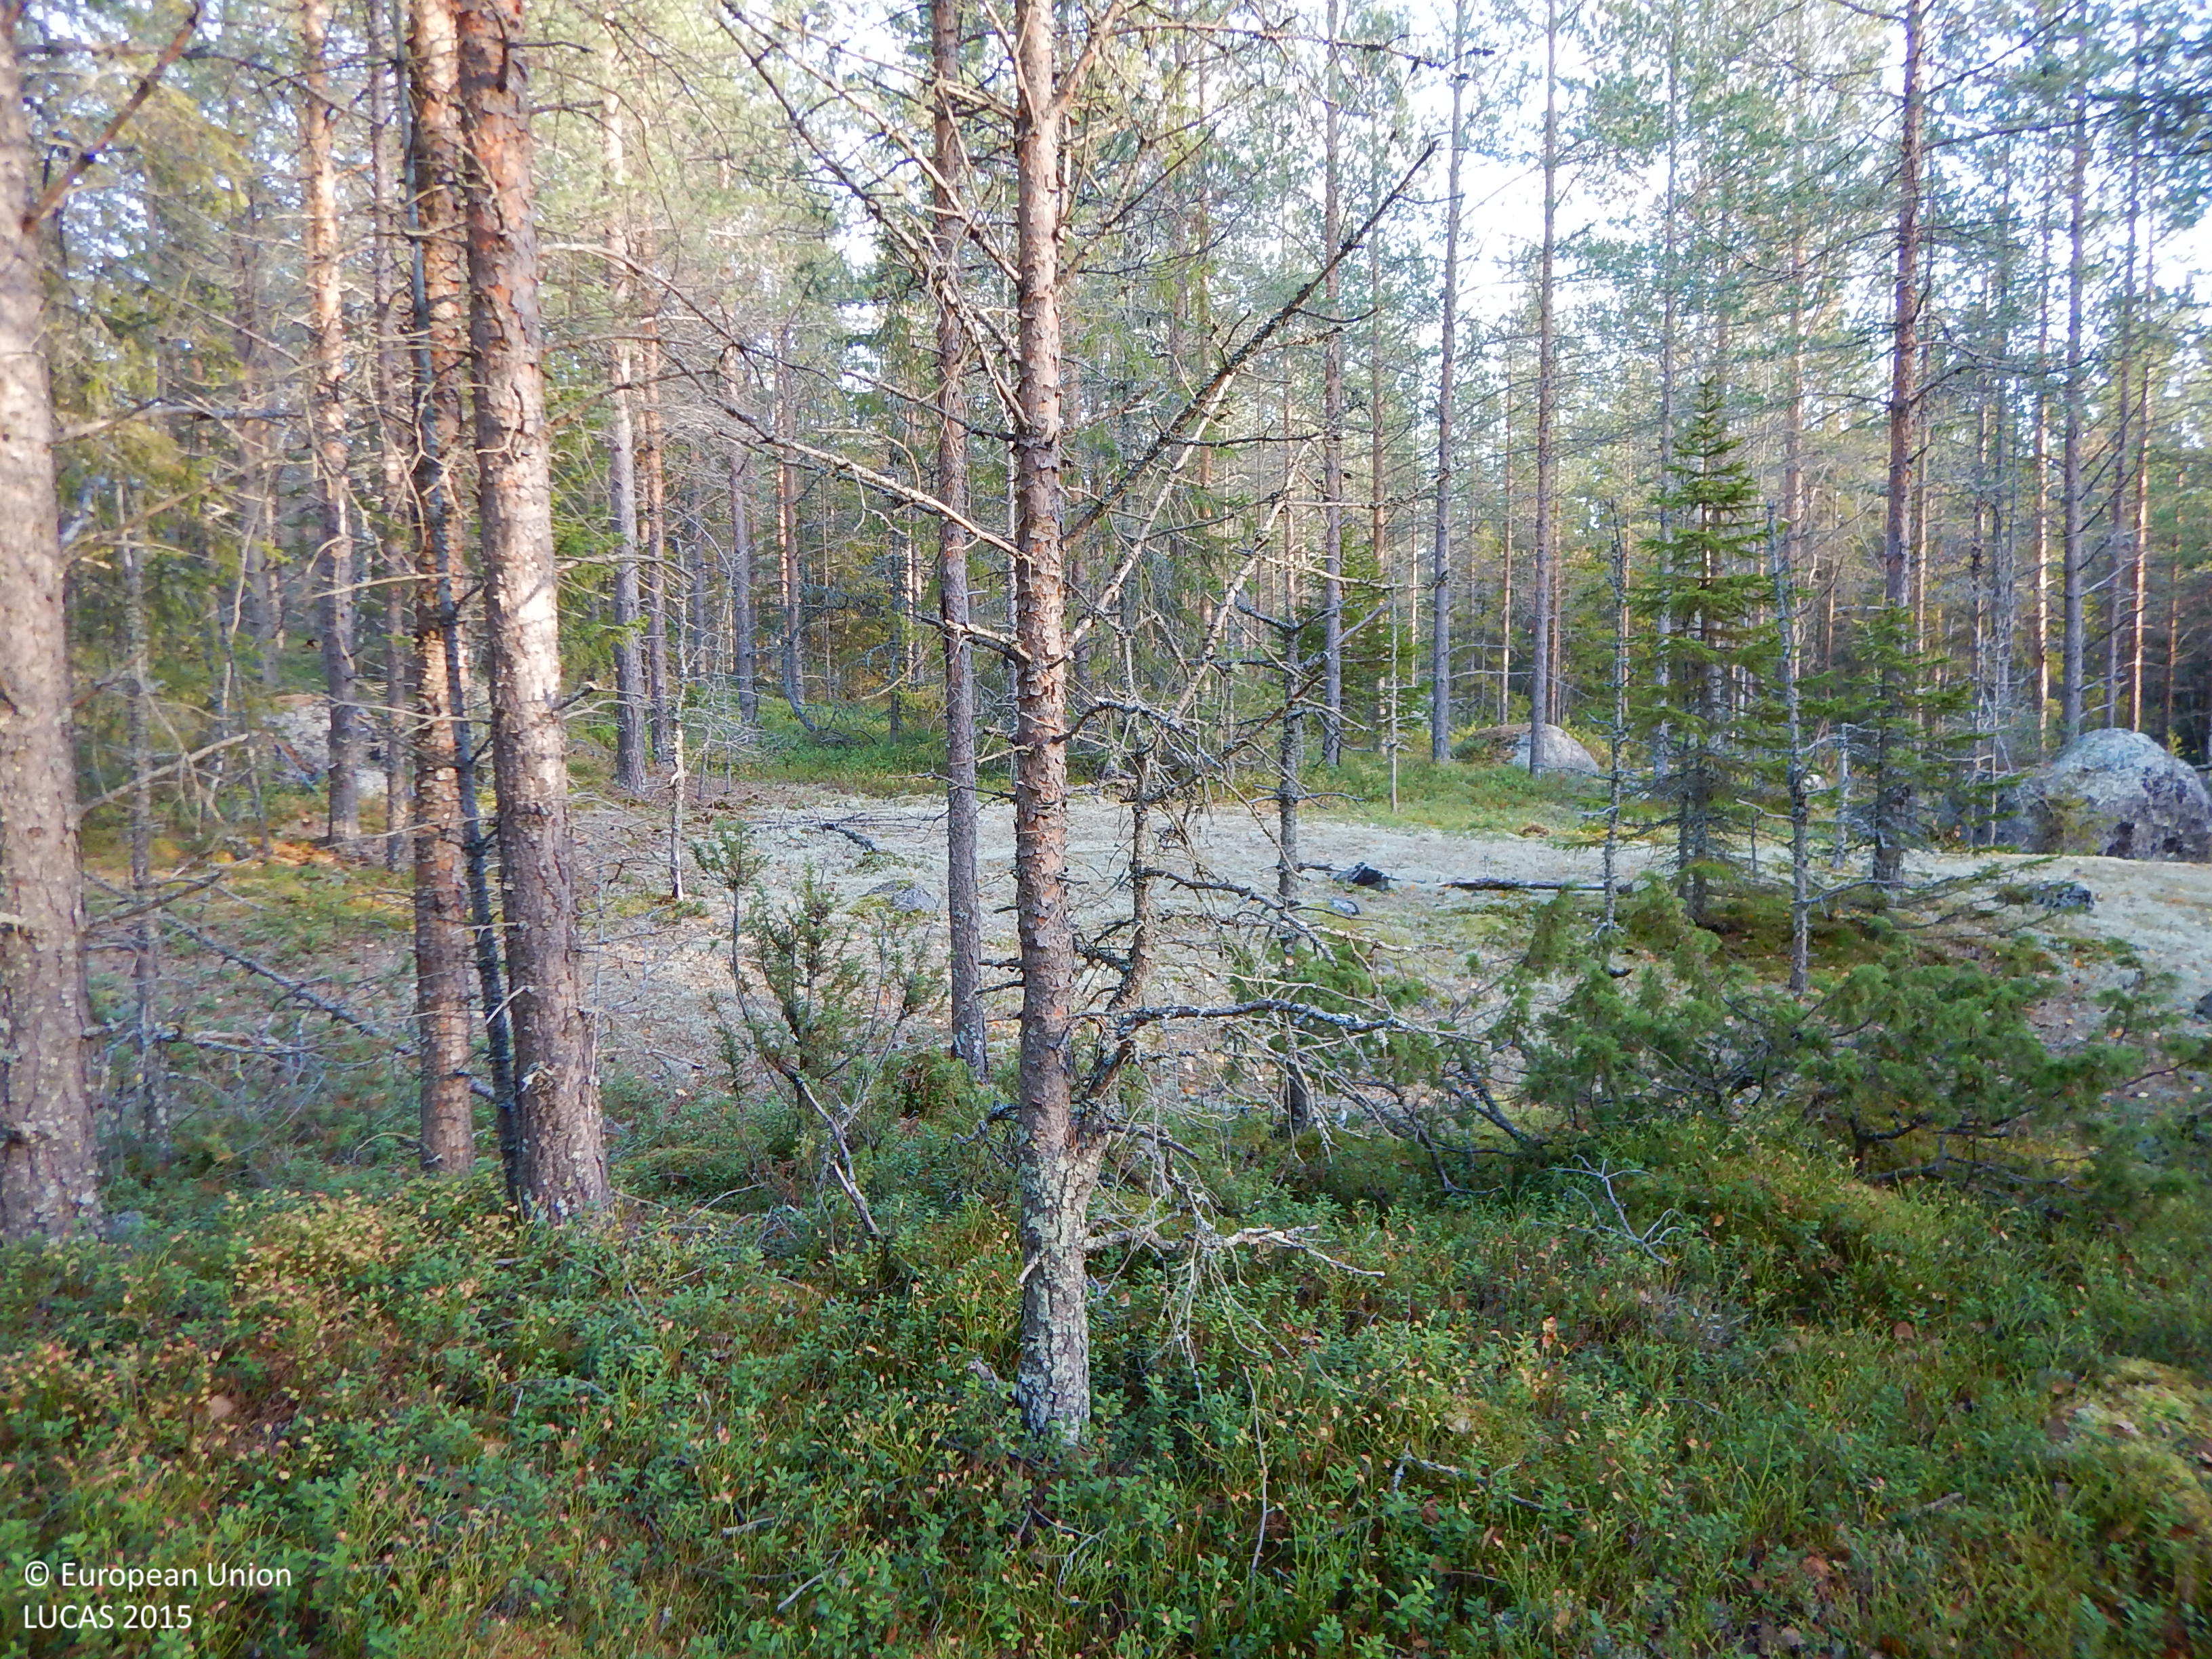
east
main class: Woodland
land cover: Pine dominated coniferous woodland
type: boreal forest
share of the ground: 50 - 75 %
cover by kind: coniferous forest trees 60 %, shrubs 20 %, lichens and mosses 15 %, herbaceous plants 5 %
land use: Forestry
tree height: > 5 m
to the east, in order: Pine dominated coniferous woodland; Other coniferous woodland; Spruce dominated coniferous woodland; Tracks; Spruce dominated mixed woodland; Broadleaved woodland
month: October
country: SE
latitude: 64.8932
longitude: 20.9815
